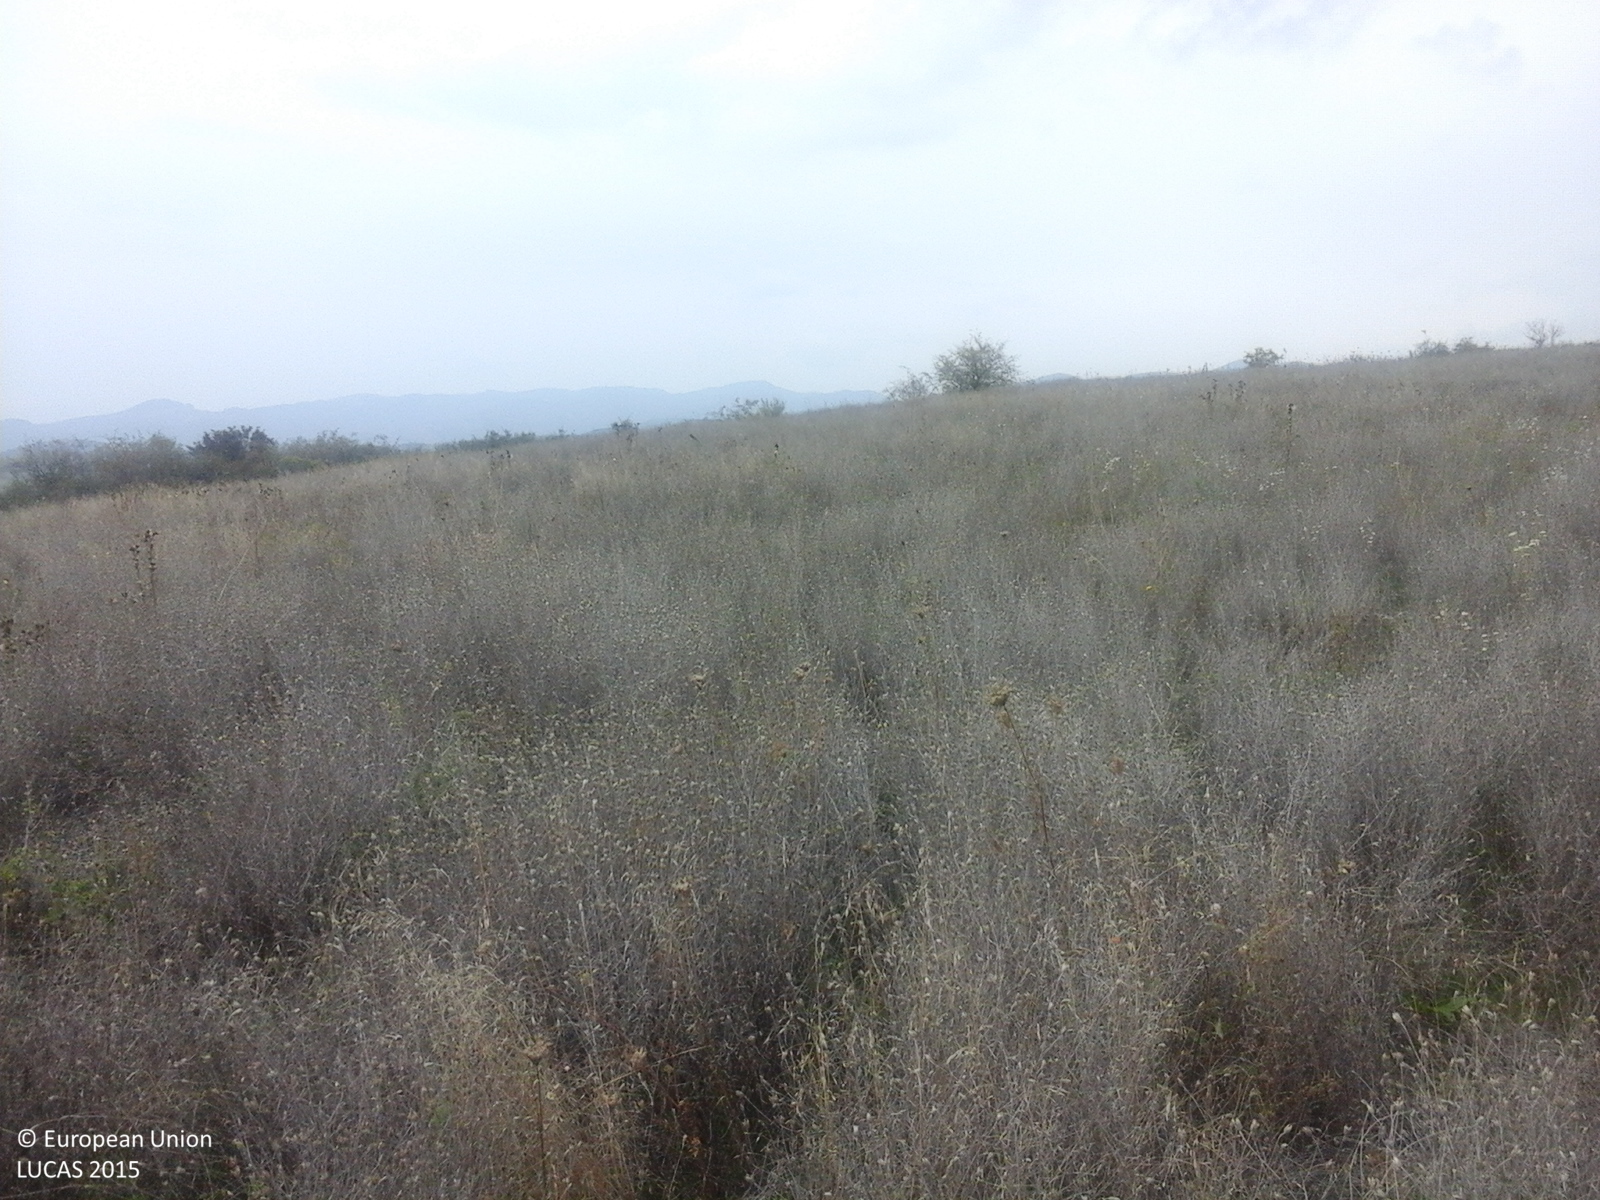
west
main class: Grassland
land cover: Spontaneously vegetated surfaces
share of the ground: > 75 %
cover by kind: herbaceous plants 100 %
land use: Agriculture (excluding fallow land and kitchen gardens)
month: October
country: RO
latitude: 46.1776
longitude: 23.5516
